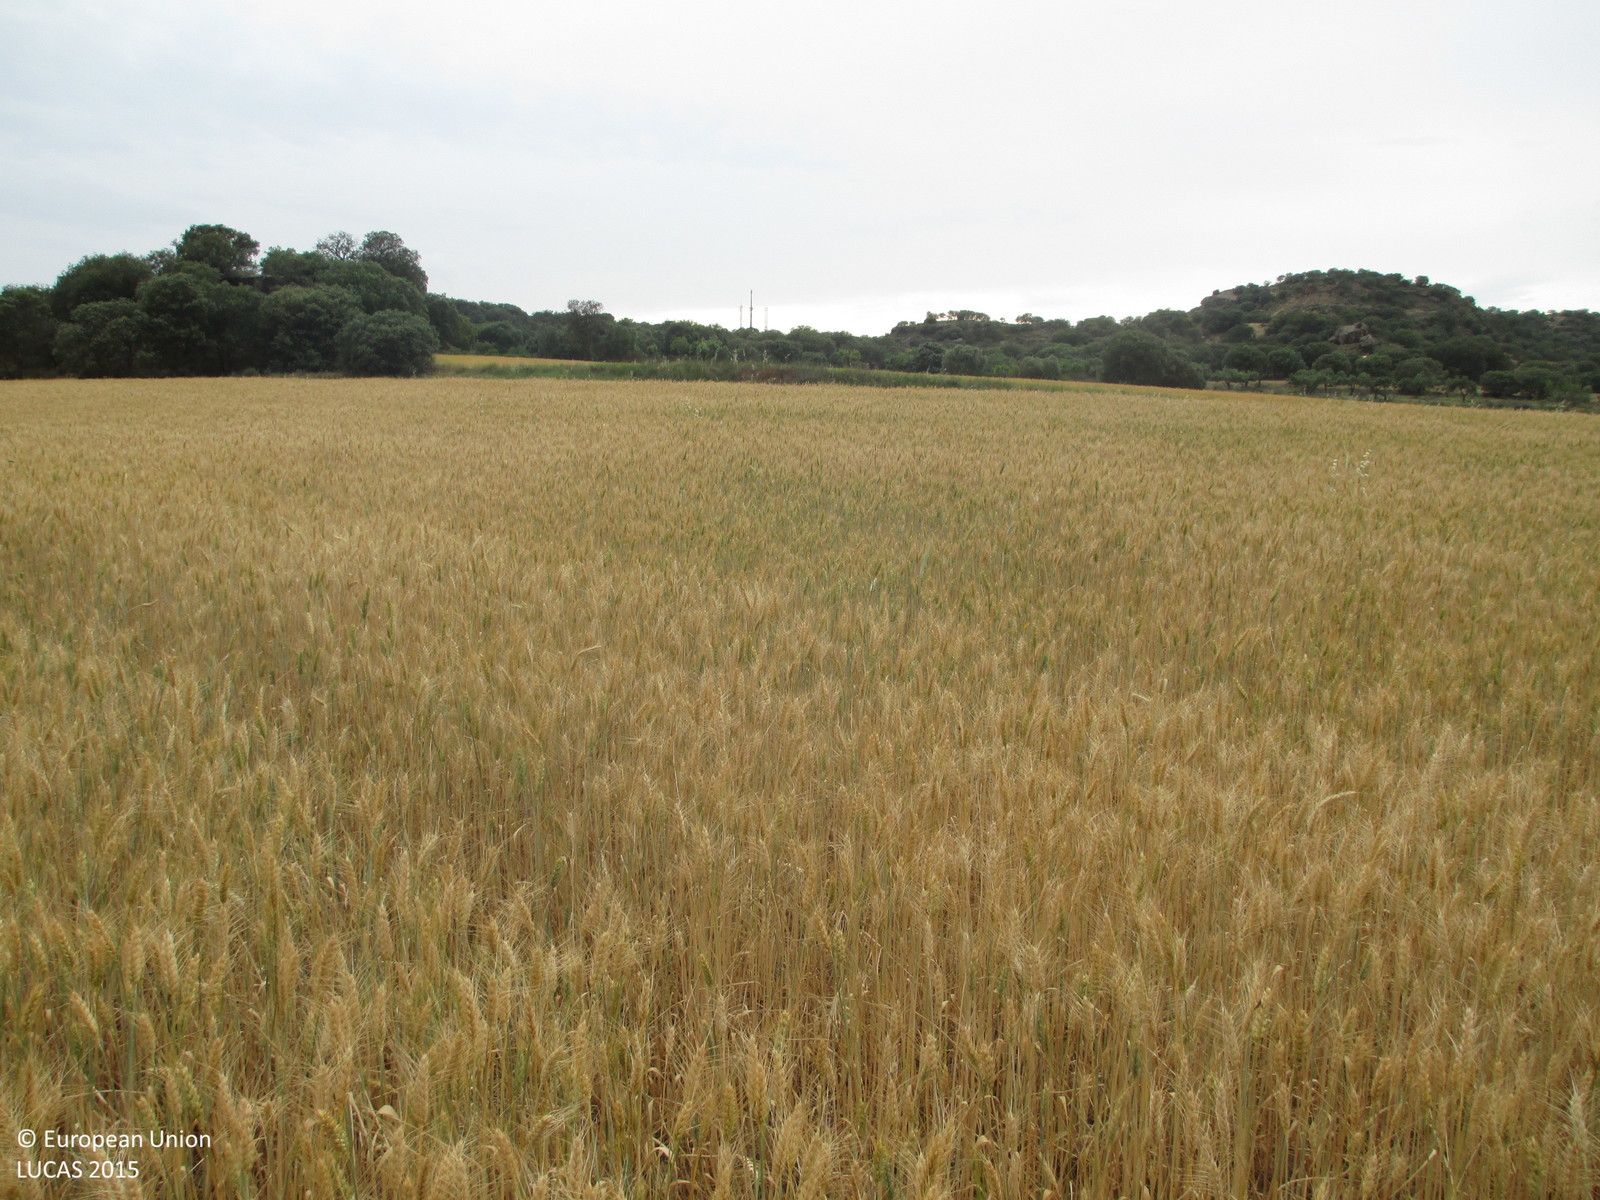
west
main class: Cropland
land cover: Durum wheat
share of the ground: > 75 %
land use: Agriculture (excluding fallow land and kitchen gardens)
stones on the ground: < 10 %
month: May
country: ES
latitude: 42.1203
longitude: -0.1933
